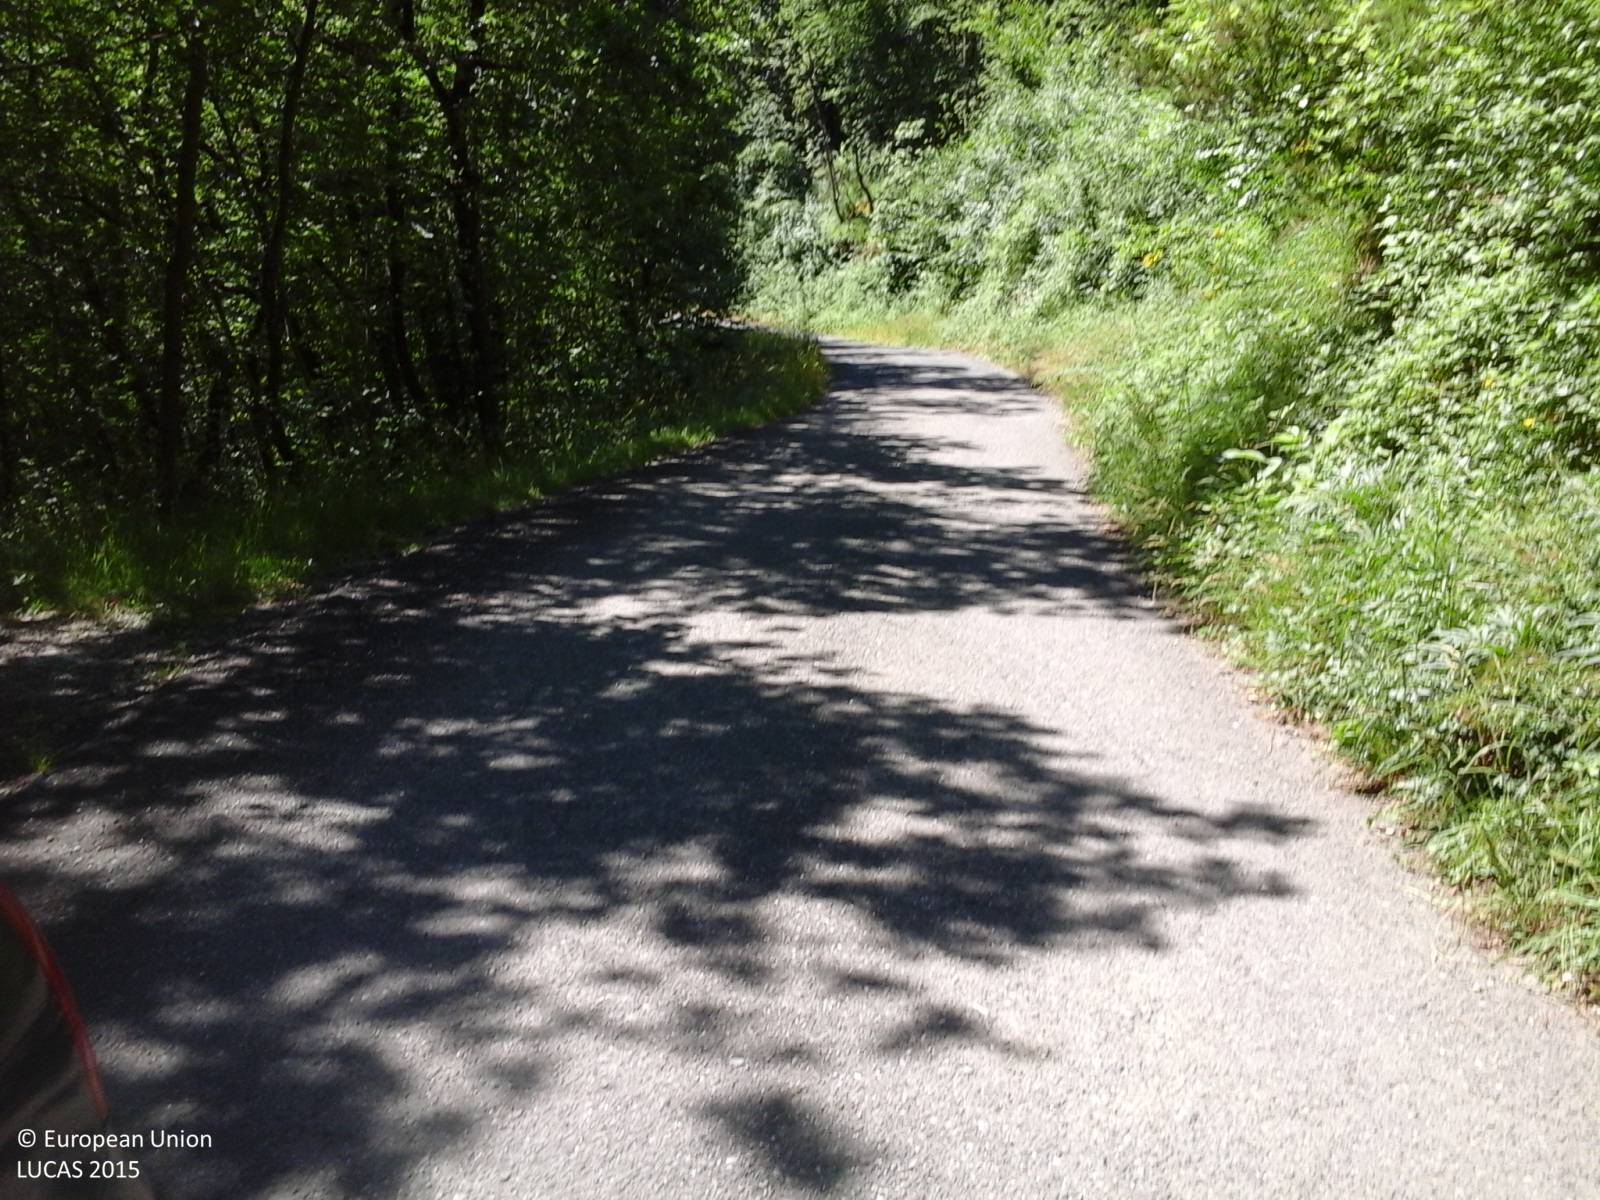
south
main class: Woodland
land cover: Broadleaved woodland
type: thermophilous deciduous forest
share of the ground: > 75 %
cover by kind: broadleaved forest trees 100 %
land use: Forestry
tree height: > 5 m
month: June
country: IT
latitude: 44.3685
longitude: 9.9124
